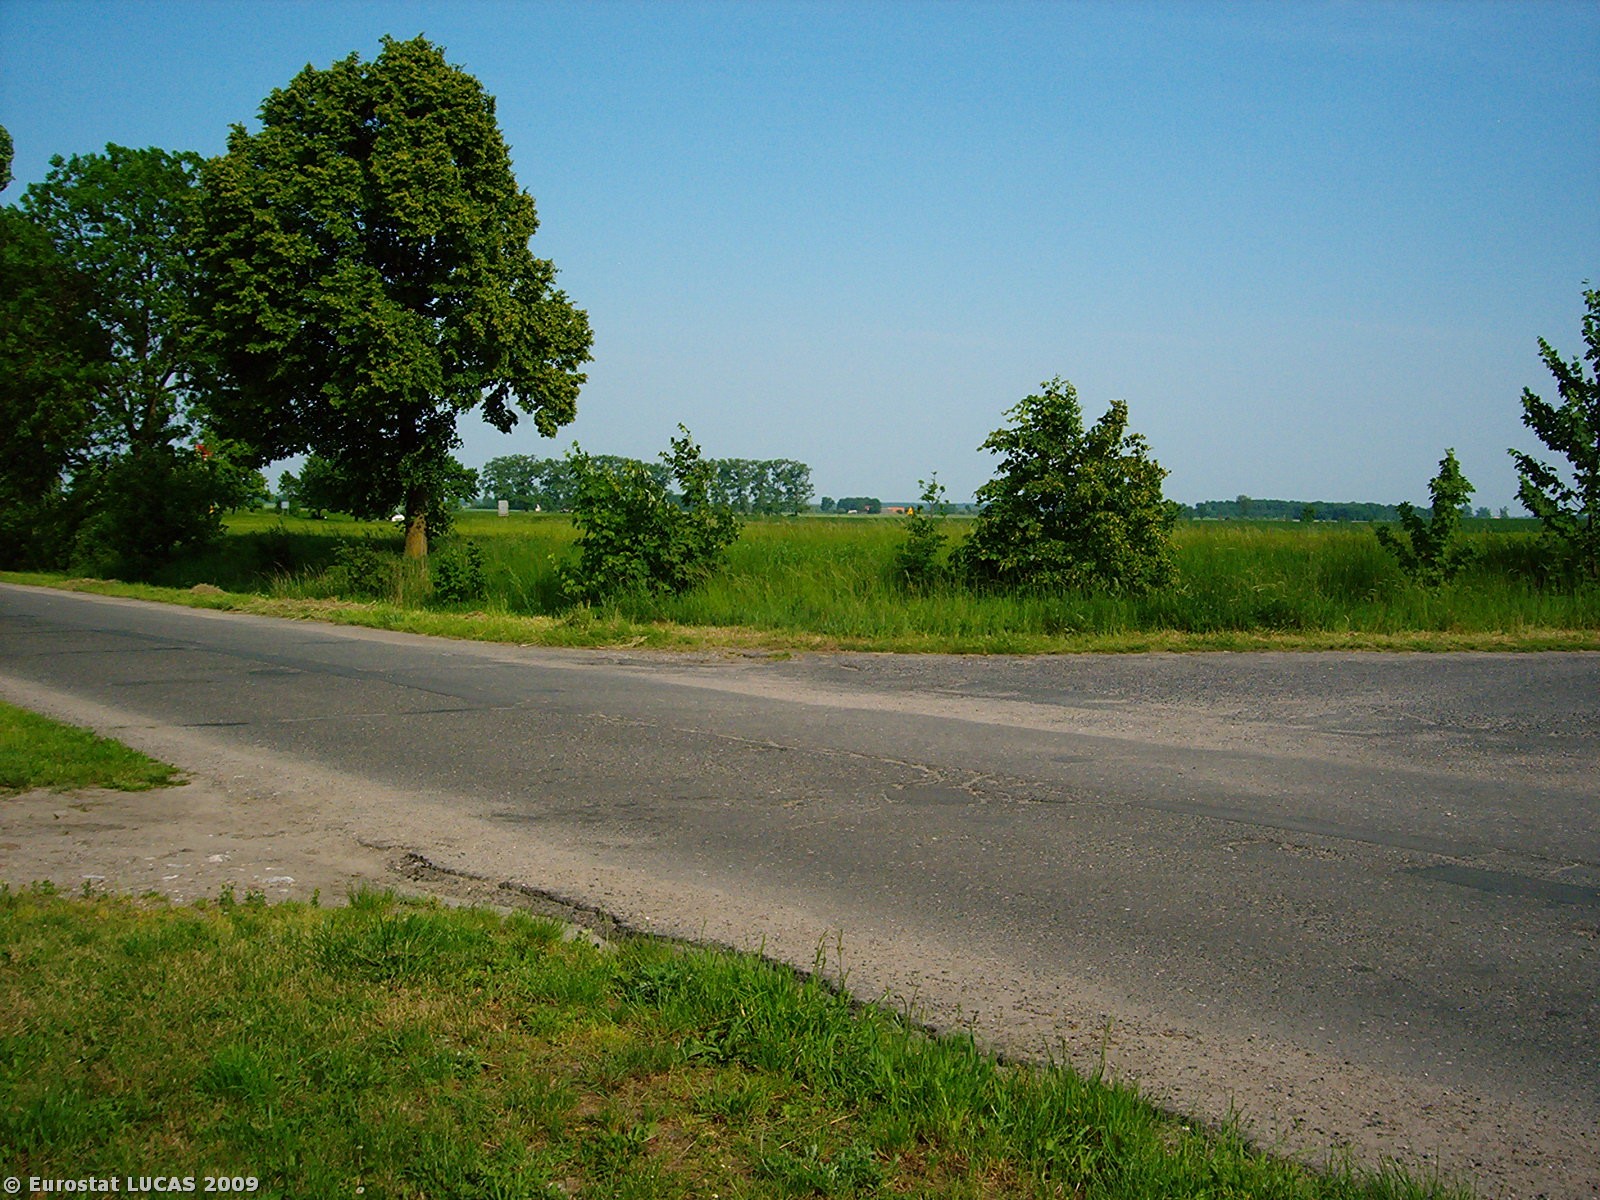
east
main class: Grassland
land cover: Grassland without tree/shrub cover
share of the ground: > 75 %
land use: Residential
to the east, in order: Grassland without tree/shrub cover; Paved roads, cycling and walking lanes; Grass margins; Lines of trees; Barley; Grass margins; Lines of trees; Ditches and canals; Grass margins
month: May
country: PL
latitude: 52.4973
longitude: 16.3259
